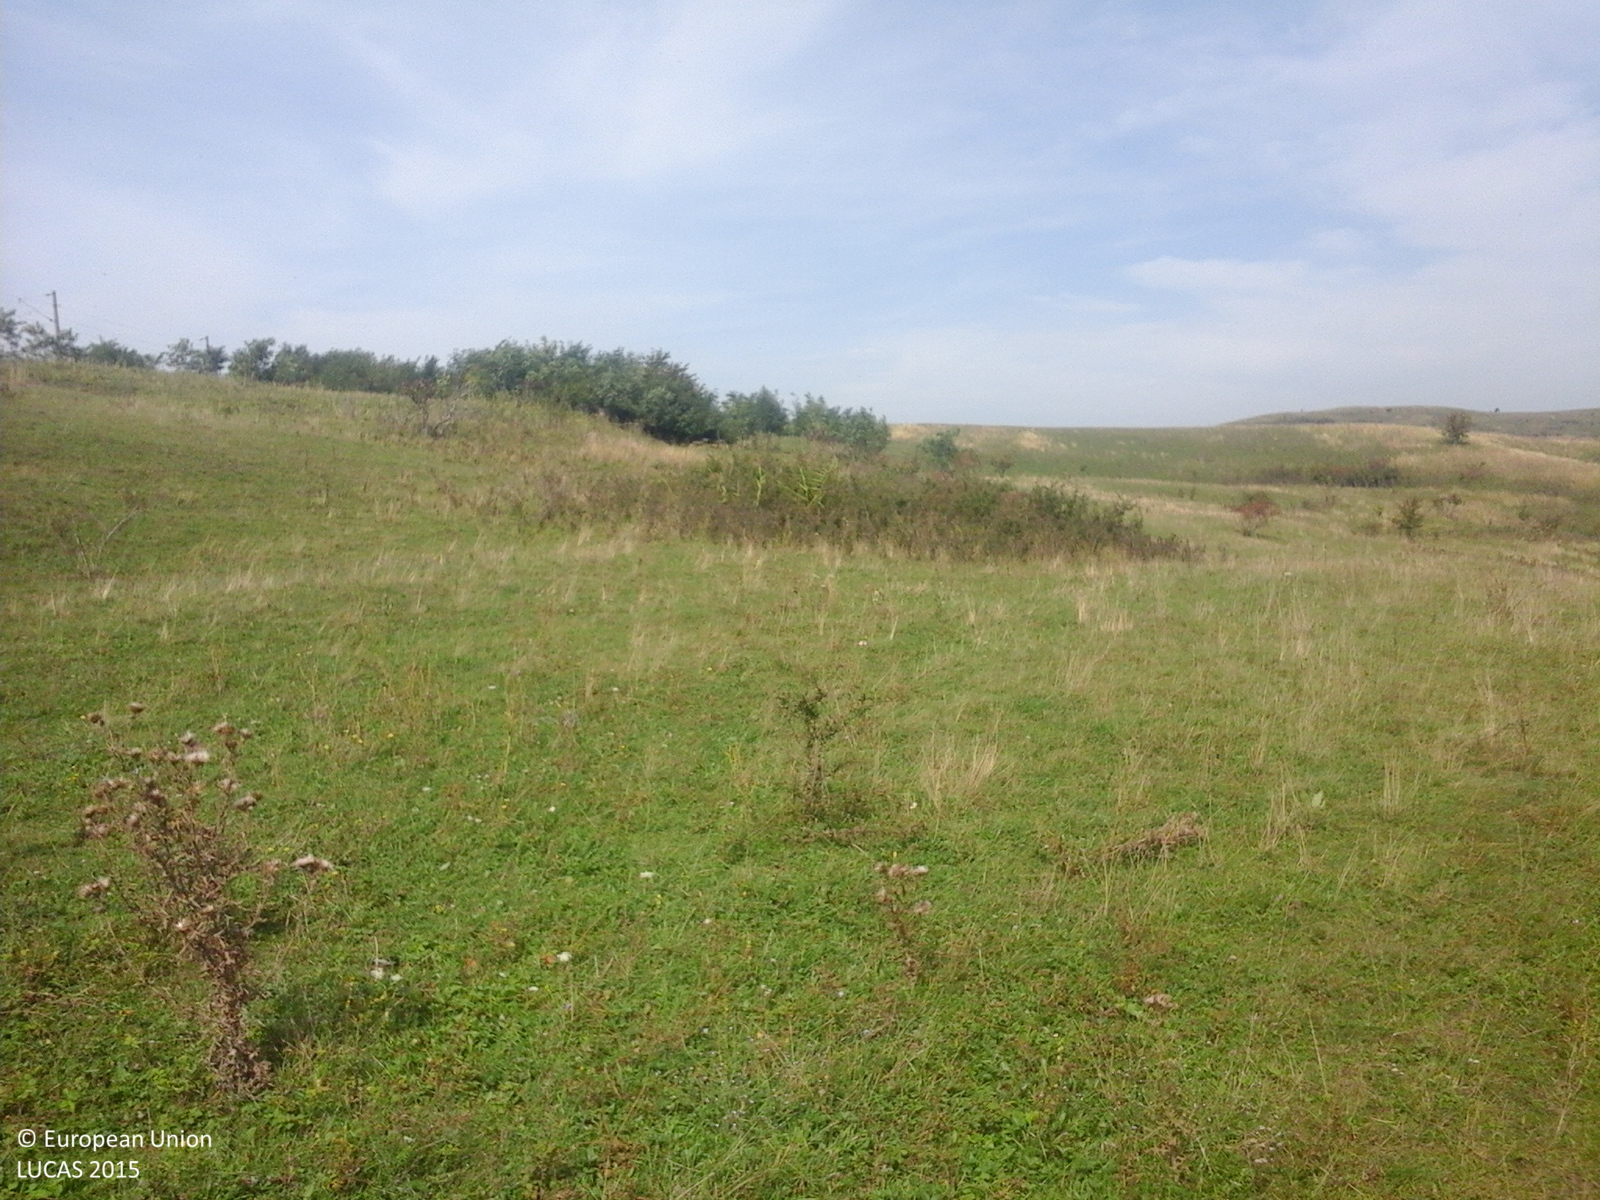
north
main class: Grassland
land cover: Grassland without tree/shrub cover
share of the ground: > 75 %
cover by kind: herbaceous plants 100 %
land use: Agriculture (excluding fallow land and kitchen gardens)
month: September
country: RO
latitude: 46.7053
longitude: 23.8481
